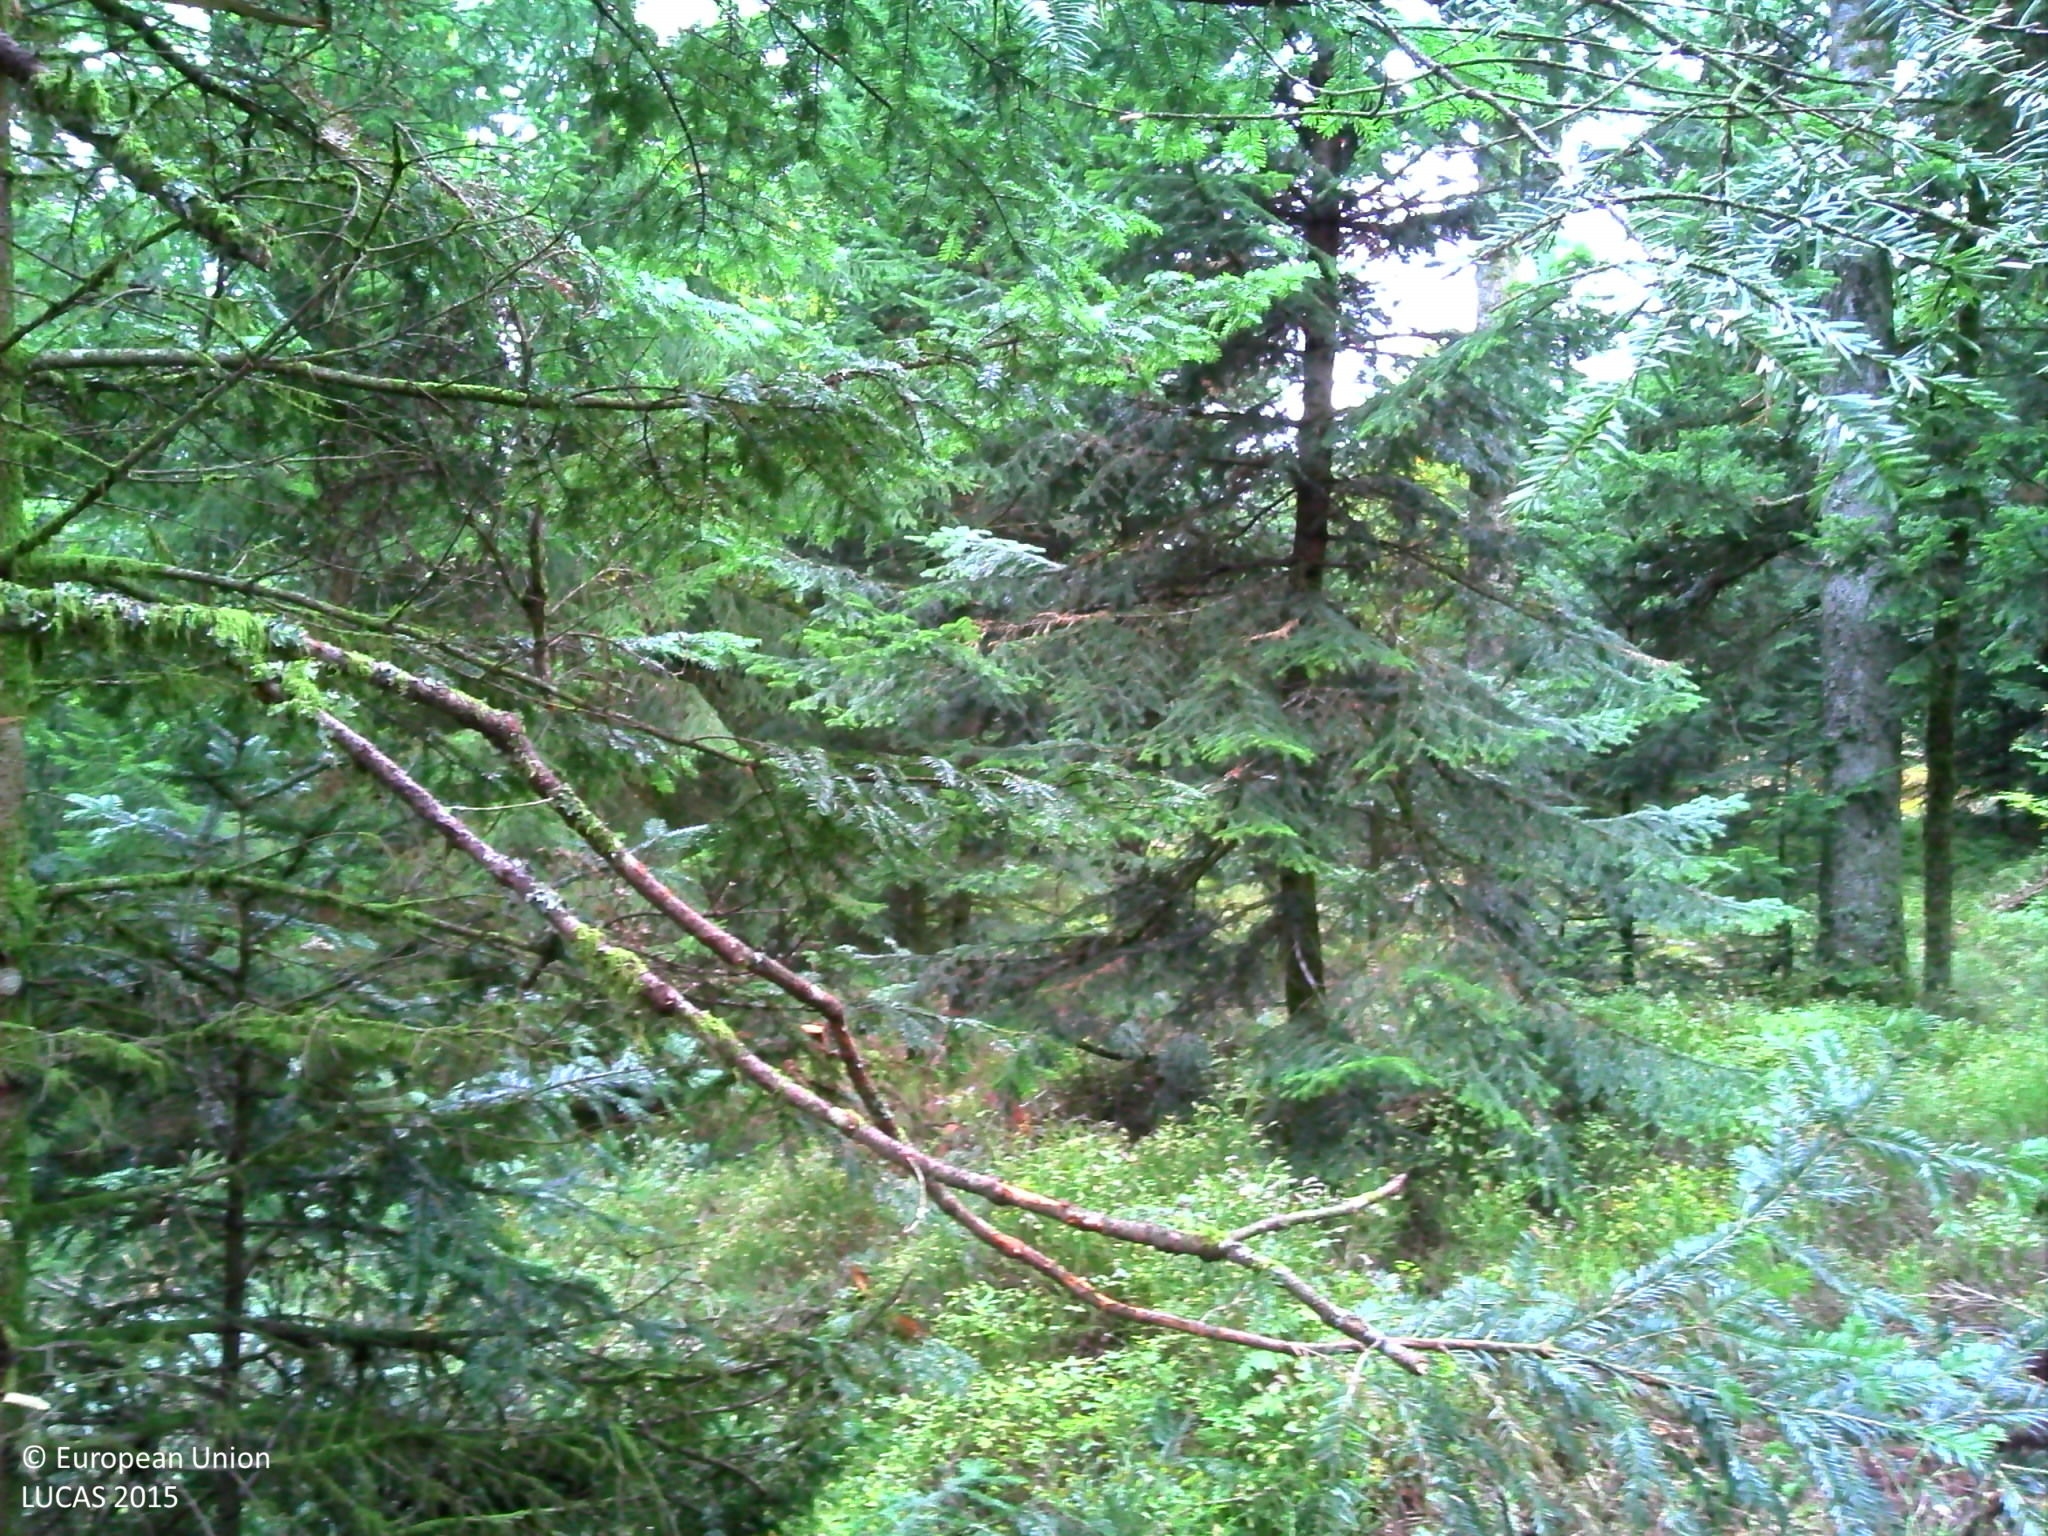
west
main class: Woodland
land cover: Other mixed woodland
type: alpine coniferous forest
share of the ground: 50 - 75 %
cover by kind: coniferous forest trees 45 %, shrubs 25 %, broadleaved forest trees 15 %, lichens and mosses 10 %, herbaceous plants 5 %
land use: Forestry
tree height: > 5 m
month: October
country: FR
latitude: 45.9467
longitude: 3.6670
